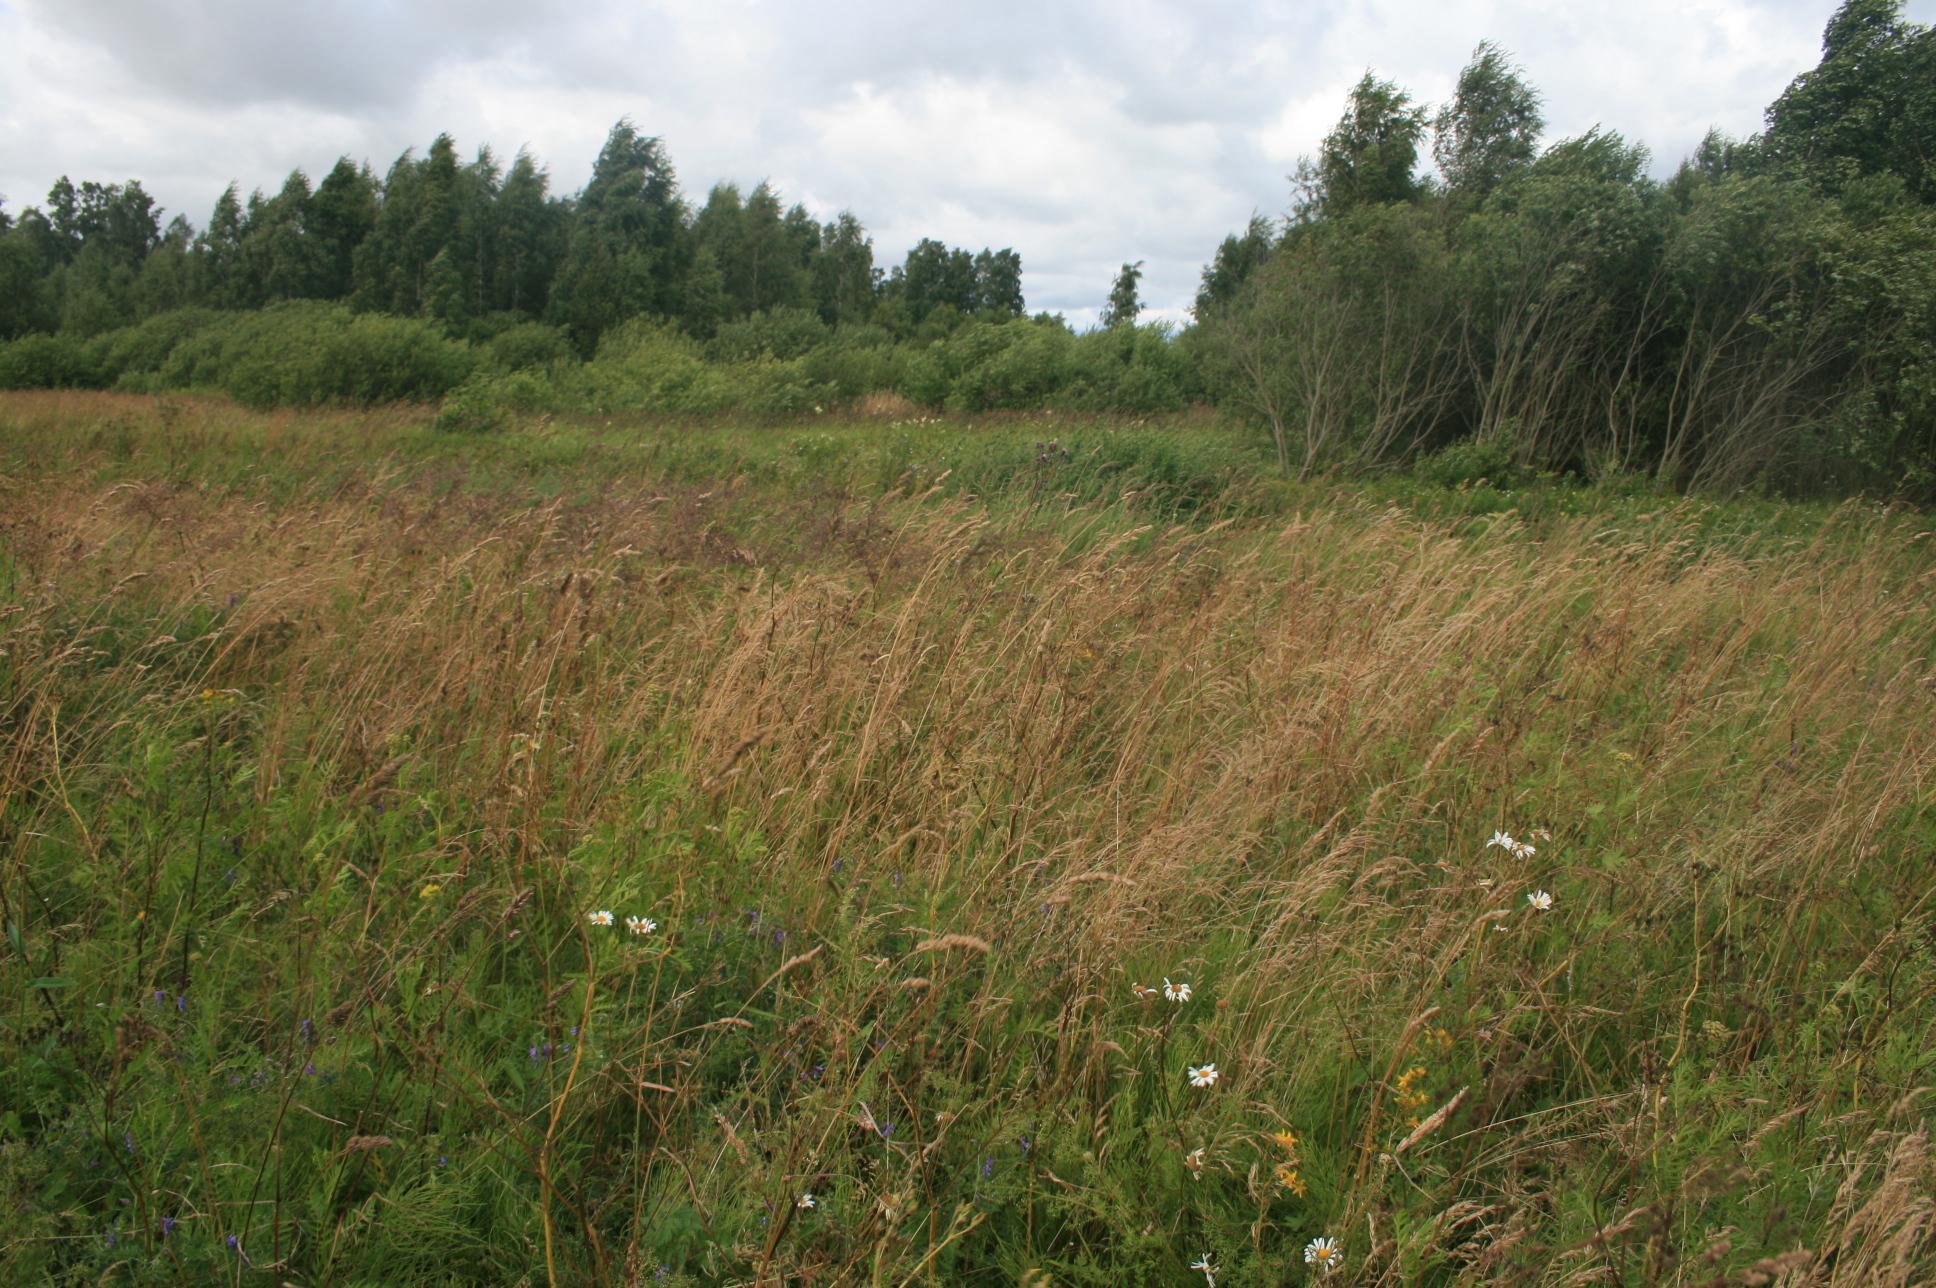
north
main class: Grassland
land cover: Grassland without tree/shrub cover
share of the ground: > 75 %
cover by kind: herbaceous plants 100 %
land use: Agriculture (excluding fallow land and kitchen gardens)
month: July
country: LT
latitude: 55.7672
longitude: 21.2143
